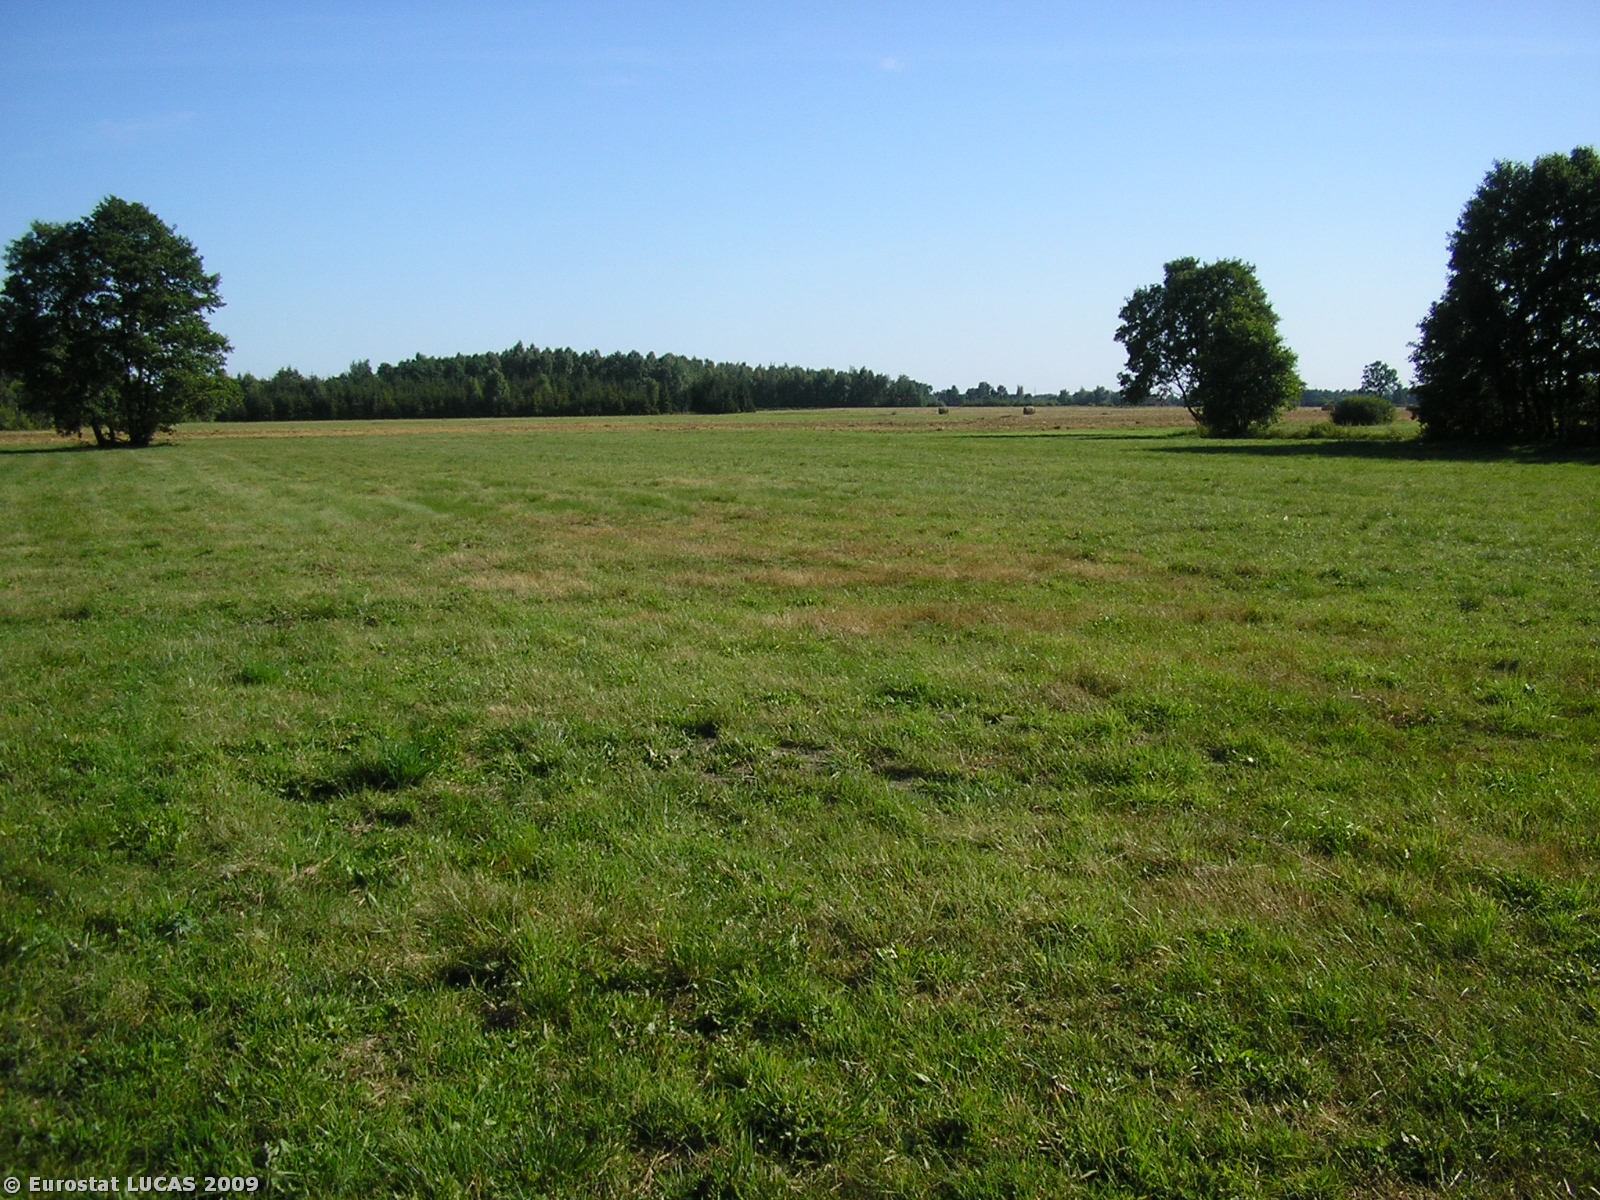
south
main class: Grassland
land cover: Grassland without tree/shrub cover
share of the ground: > 75 %
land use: Agriculture (excluding fallow land and kitchen gardens)
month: August
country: PL
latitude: 51.9973
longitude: 19.4802
